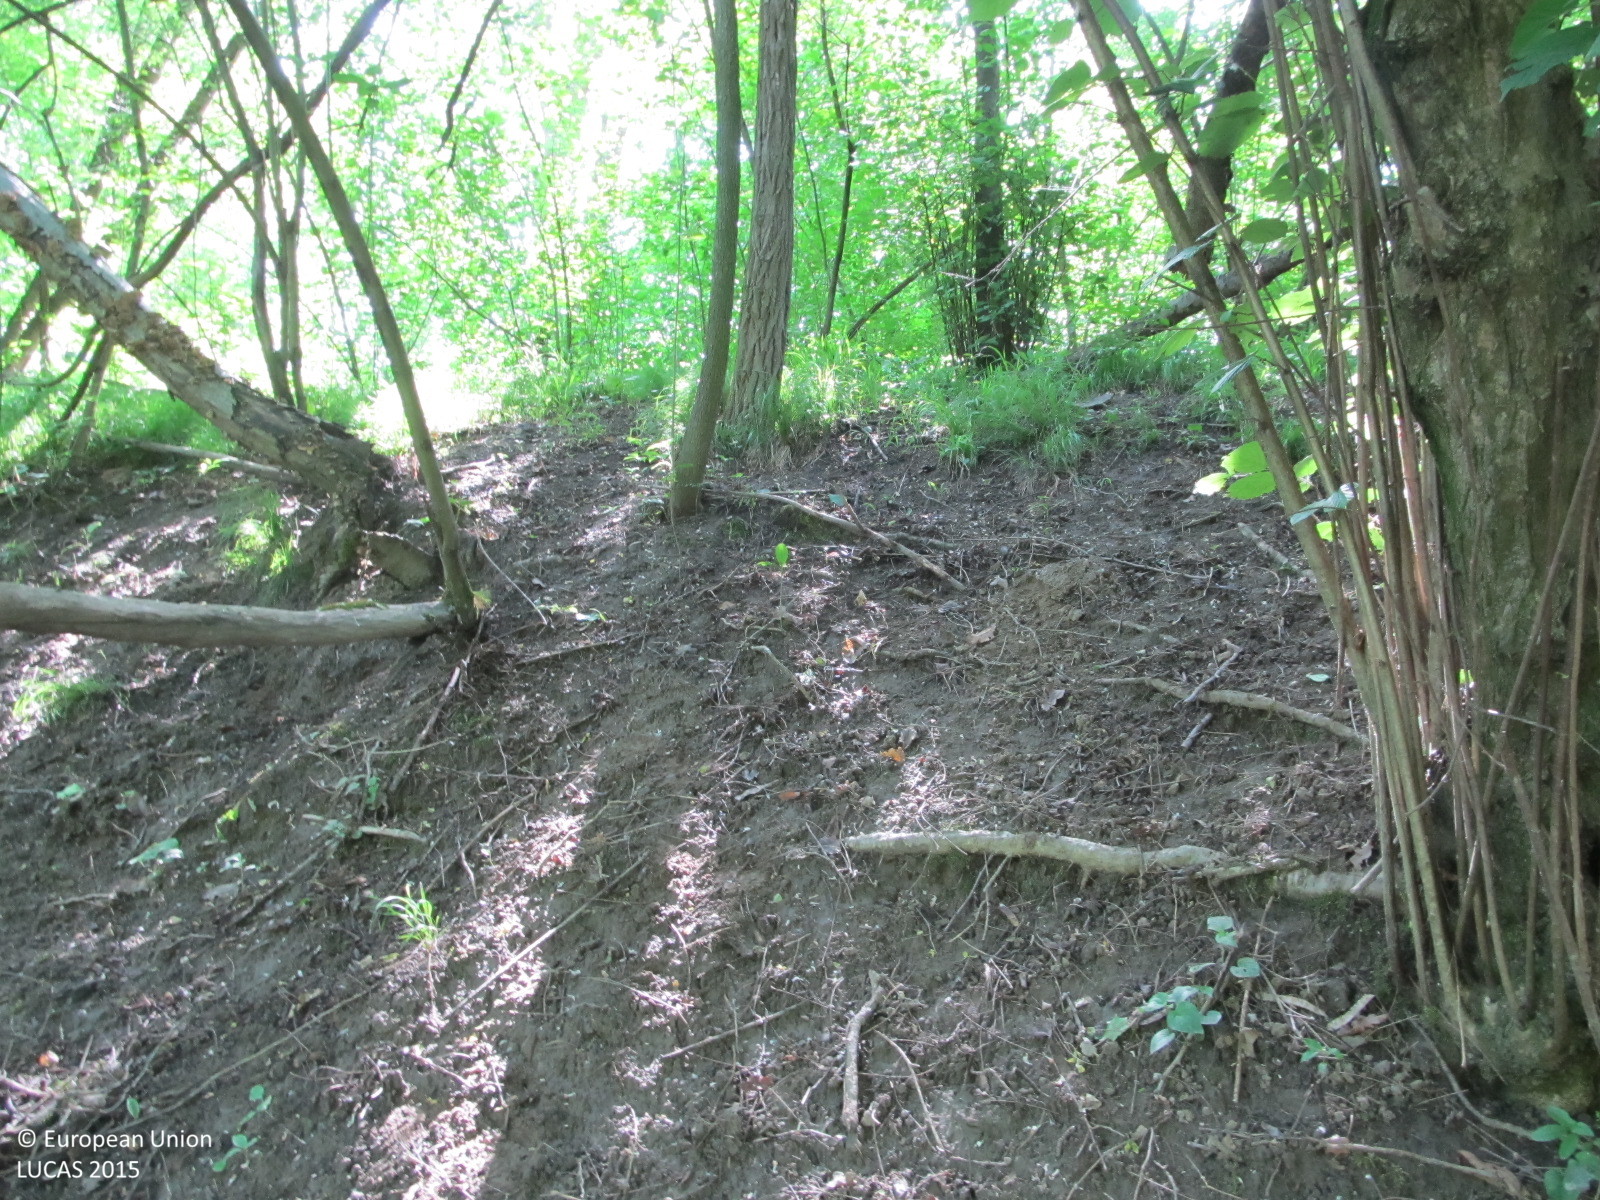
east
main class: Woodland
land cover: Broadleaved woodland
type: floodplain forest
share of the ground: 50 - 75 %
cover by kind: broadleaved forest trees 70 %, shrubs 20 %, herbaceous plants 10 %
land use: Forestry
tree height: > 5 m
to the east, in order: Broadleaved woodland; Inland fresh water bodies; Broadleaved woodland; Tracks; Fences; Broadleaved woodland; Inland fresh water bodies
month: May
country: AT
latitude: 48.3957
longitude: 15.7975
